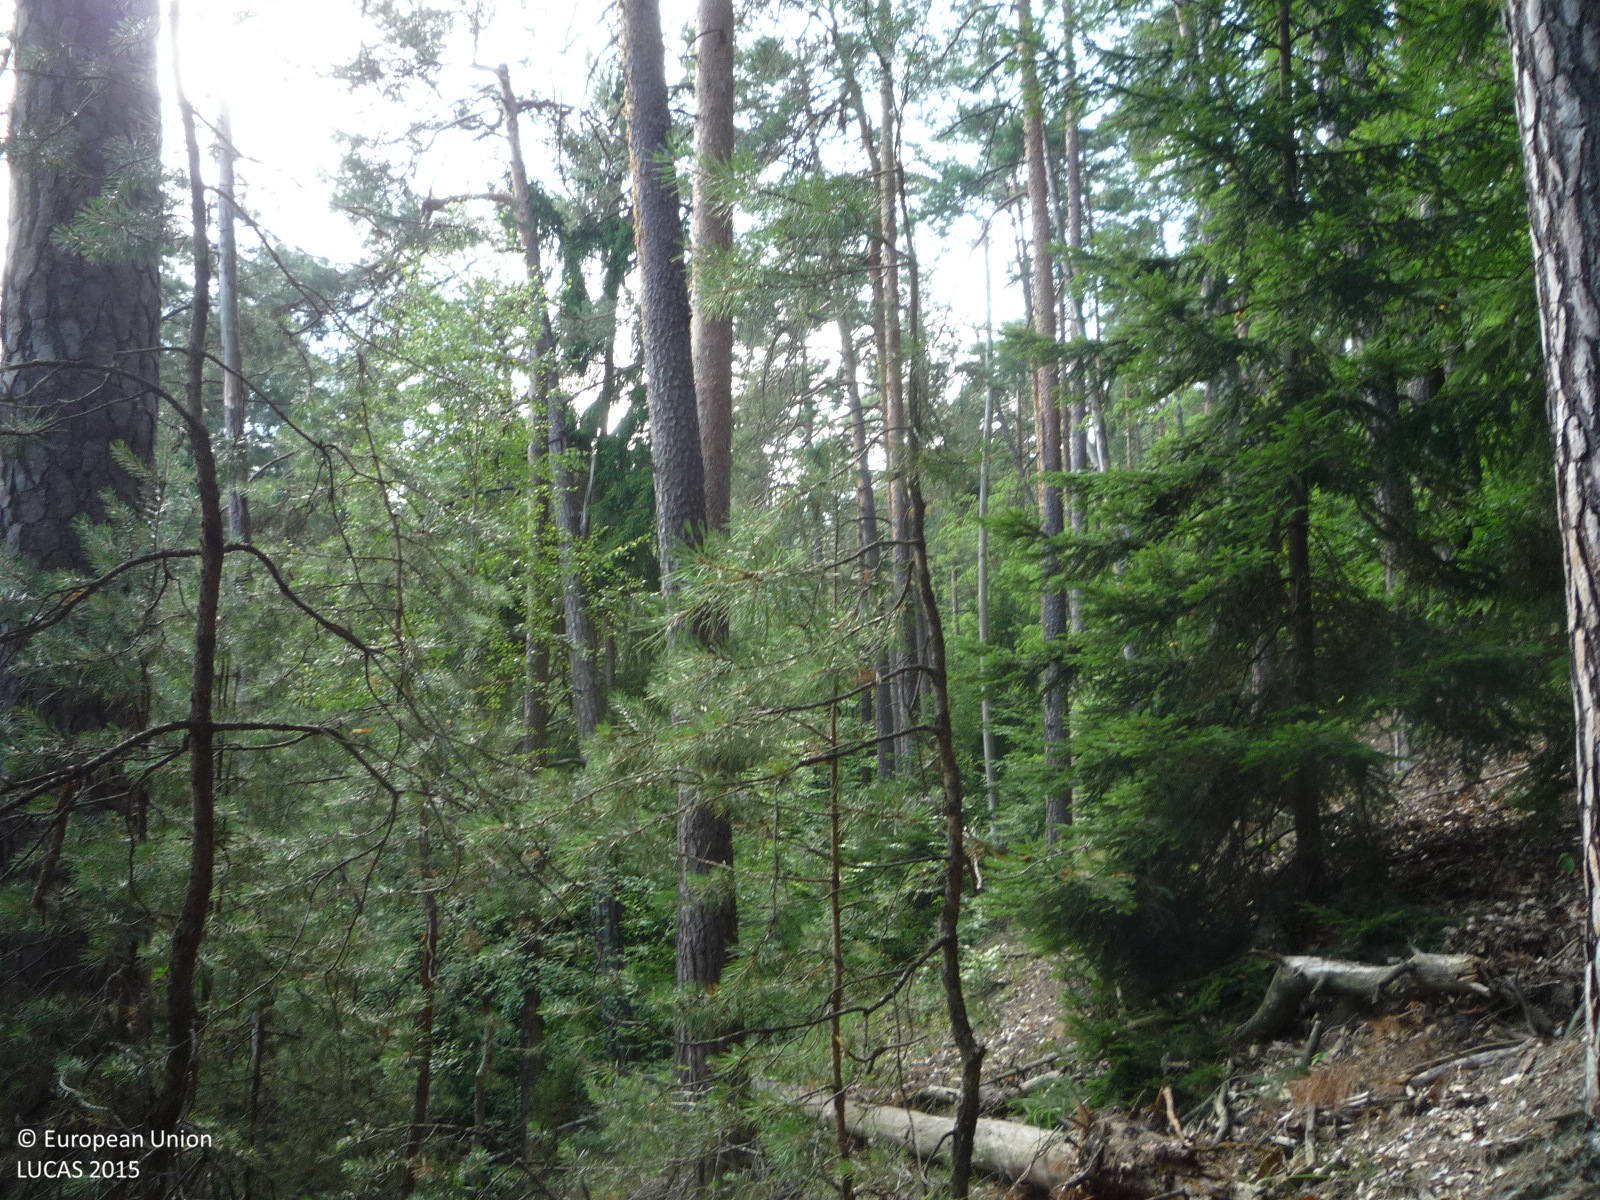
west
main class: Woodland
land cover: Pine dominated coniferous woodland
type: hemiboreal forest and nemoral coniferous forest and mixed broadleaved-coniferous forest
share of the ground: > 75 %
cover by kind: coniferous forest trees 85 %, broadleaved forest trees 10 %, unconsolidated bare surface 5 %
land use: Forestry
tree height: > 5 m
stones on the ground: < 10 %
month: July
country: CZ
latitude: 50.5987
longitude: 14.9617
